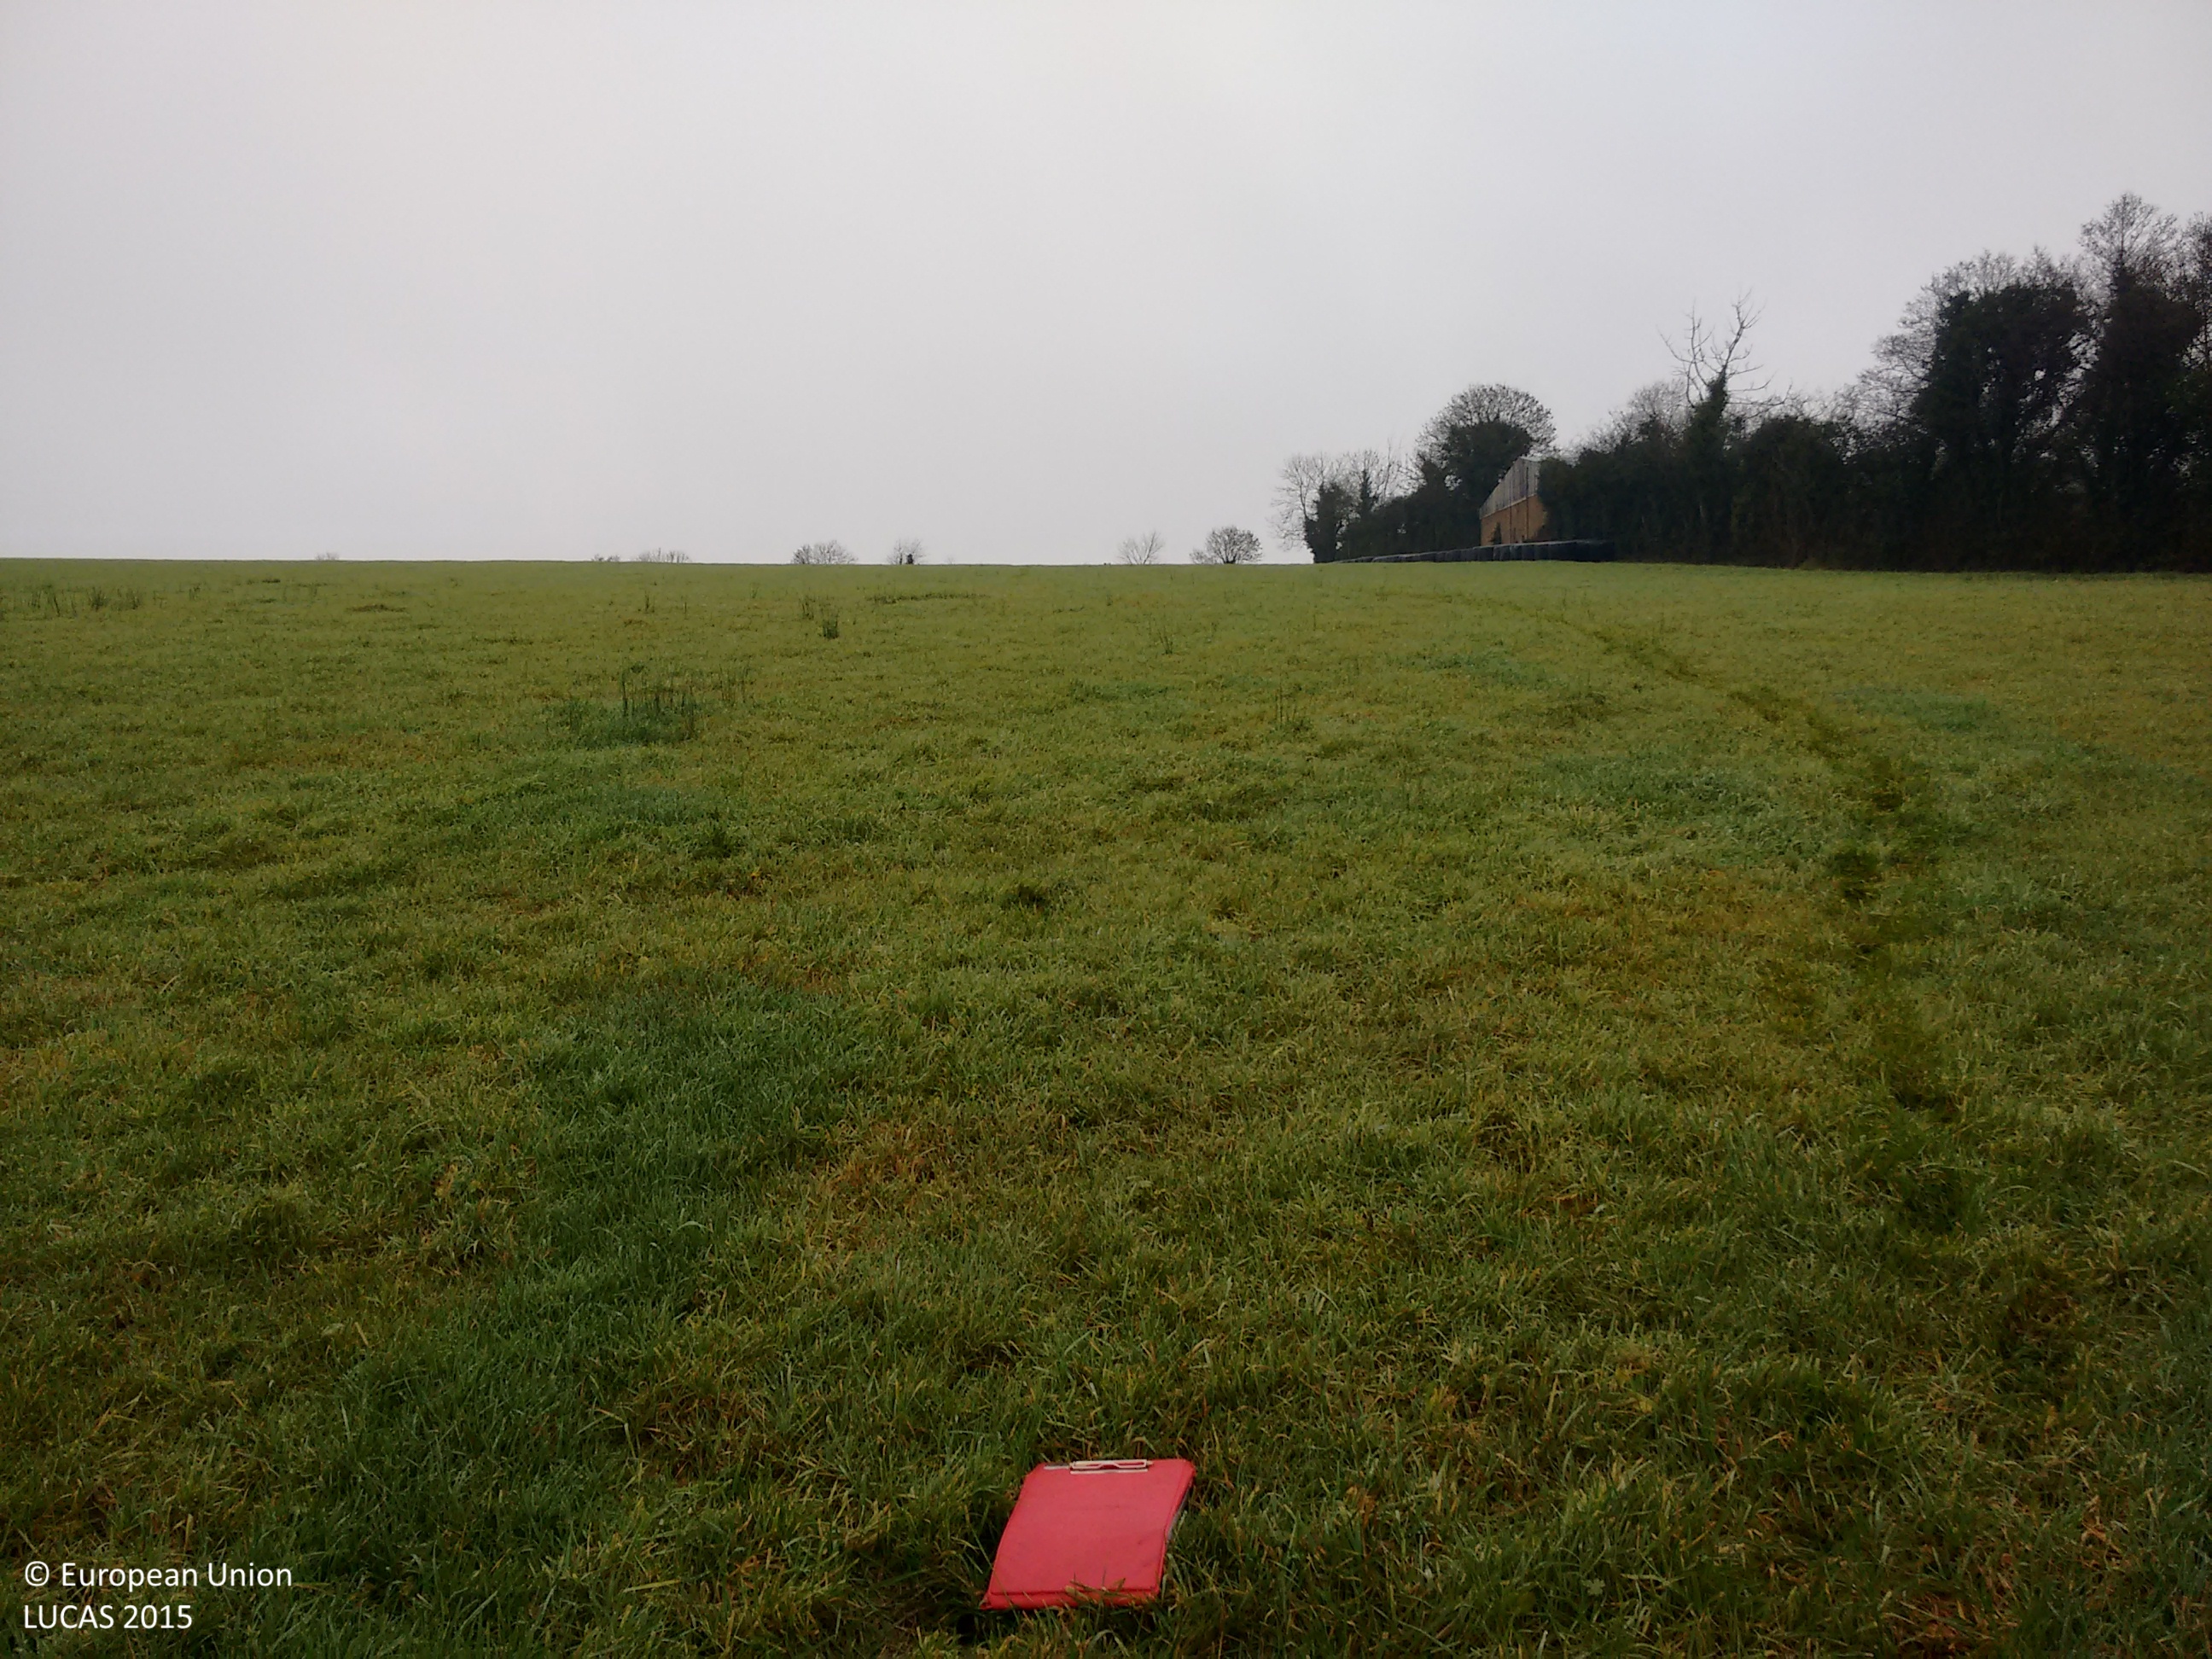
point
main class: Grassland
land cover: Grassland without tree/shrub cover
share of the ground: > 75 %
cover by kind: herbaceous plants 100 %
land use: Agriculture (excluding fallow land and kitchen gardens)
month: December
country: GB
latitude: 54.2094
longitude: -7.2758
